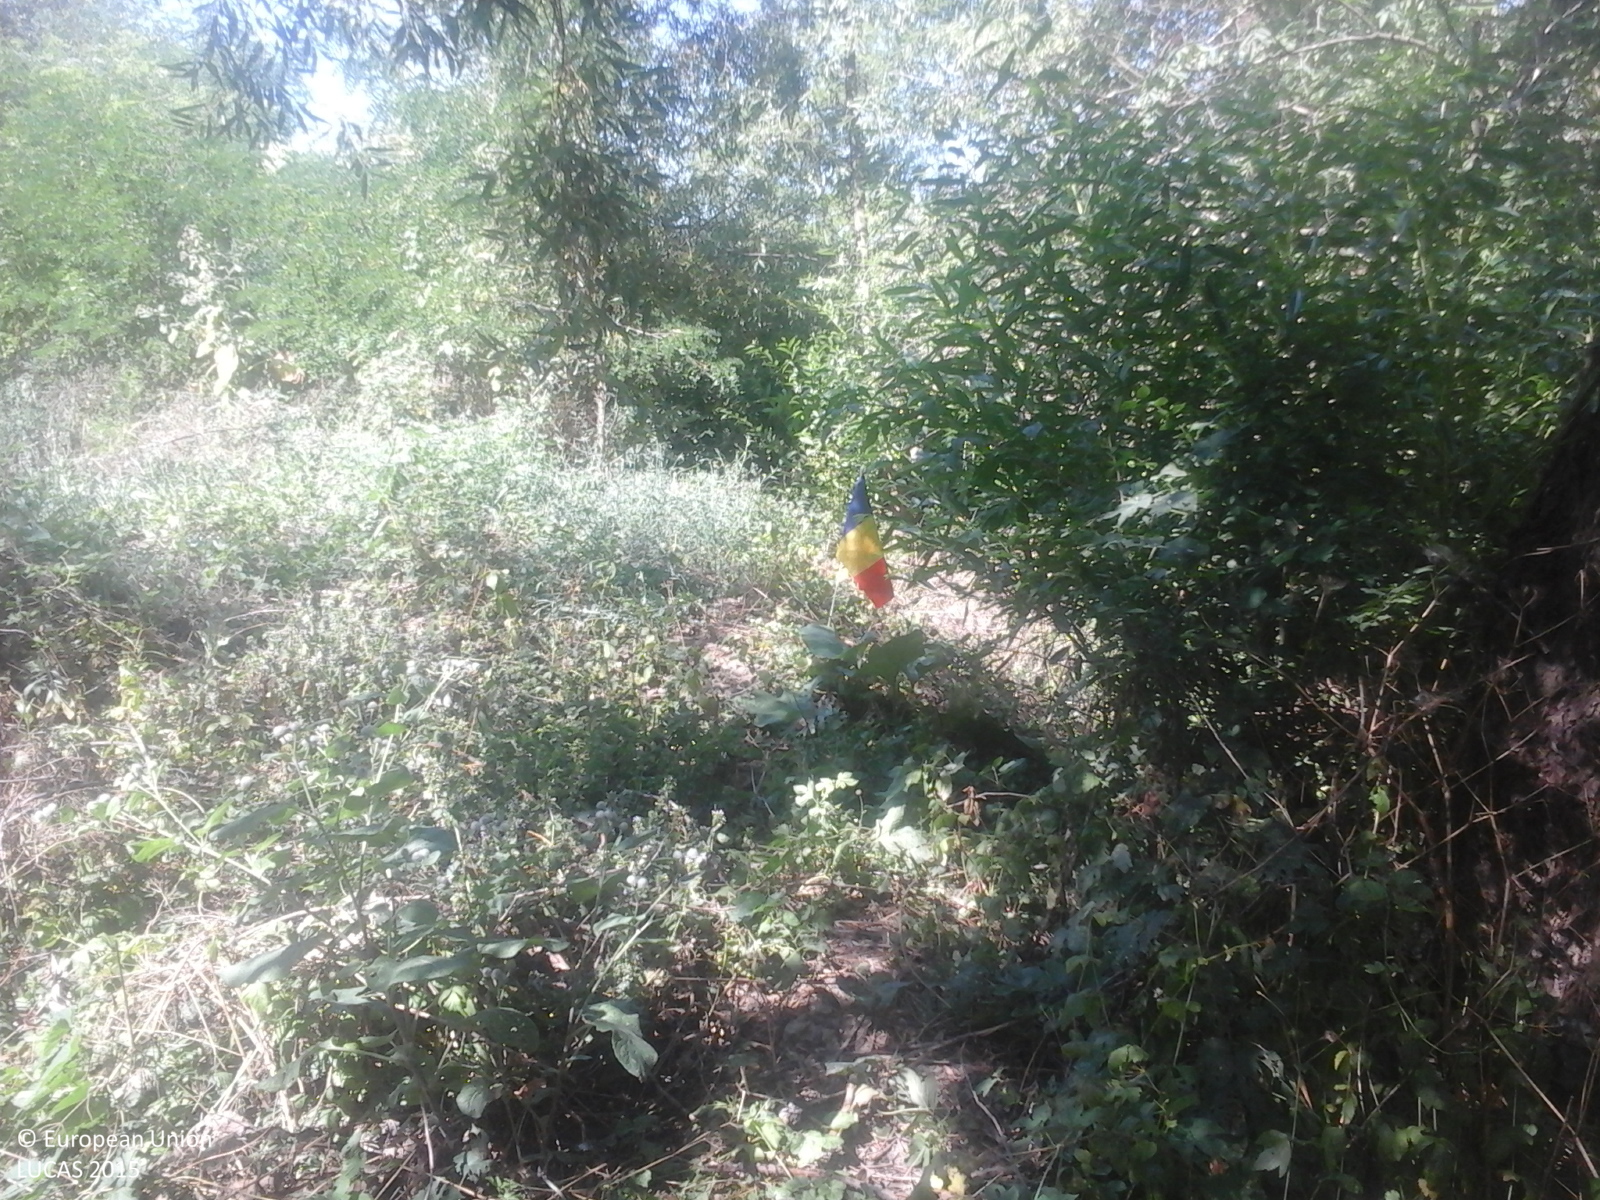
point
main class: Woodland
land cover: Broadleaved woodland
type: exotic forest
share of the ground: > 75 %
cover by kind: broadleaved forest trees 100 %
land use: Forestry
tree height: > 5 m
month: July
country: RO
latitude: 46.6793
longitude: 28.0530
